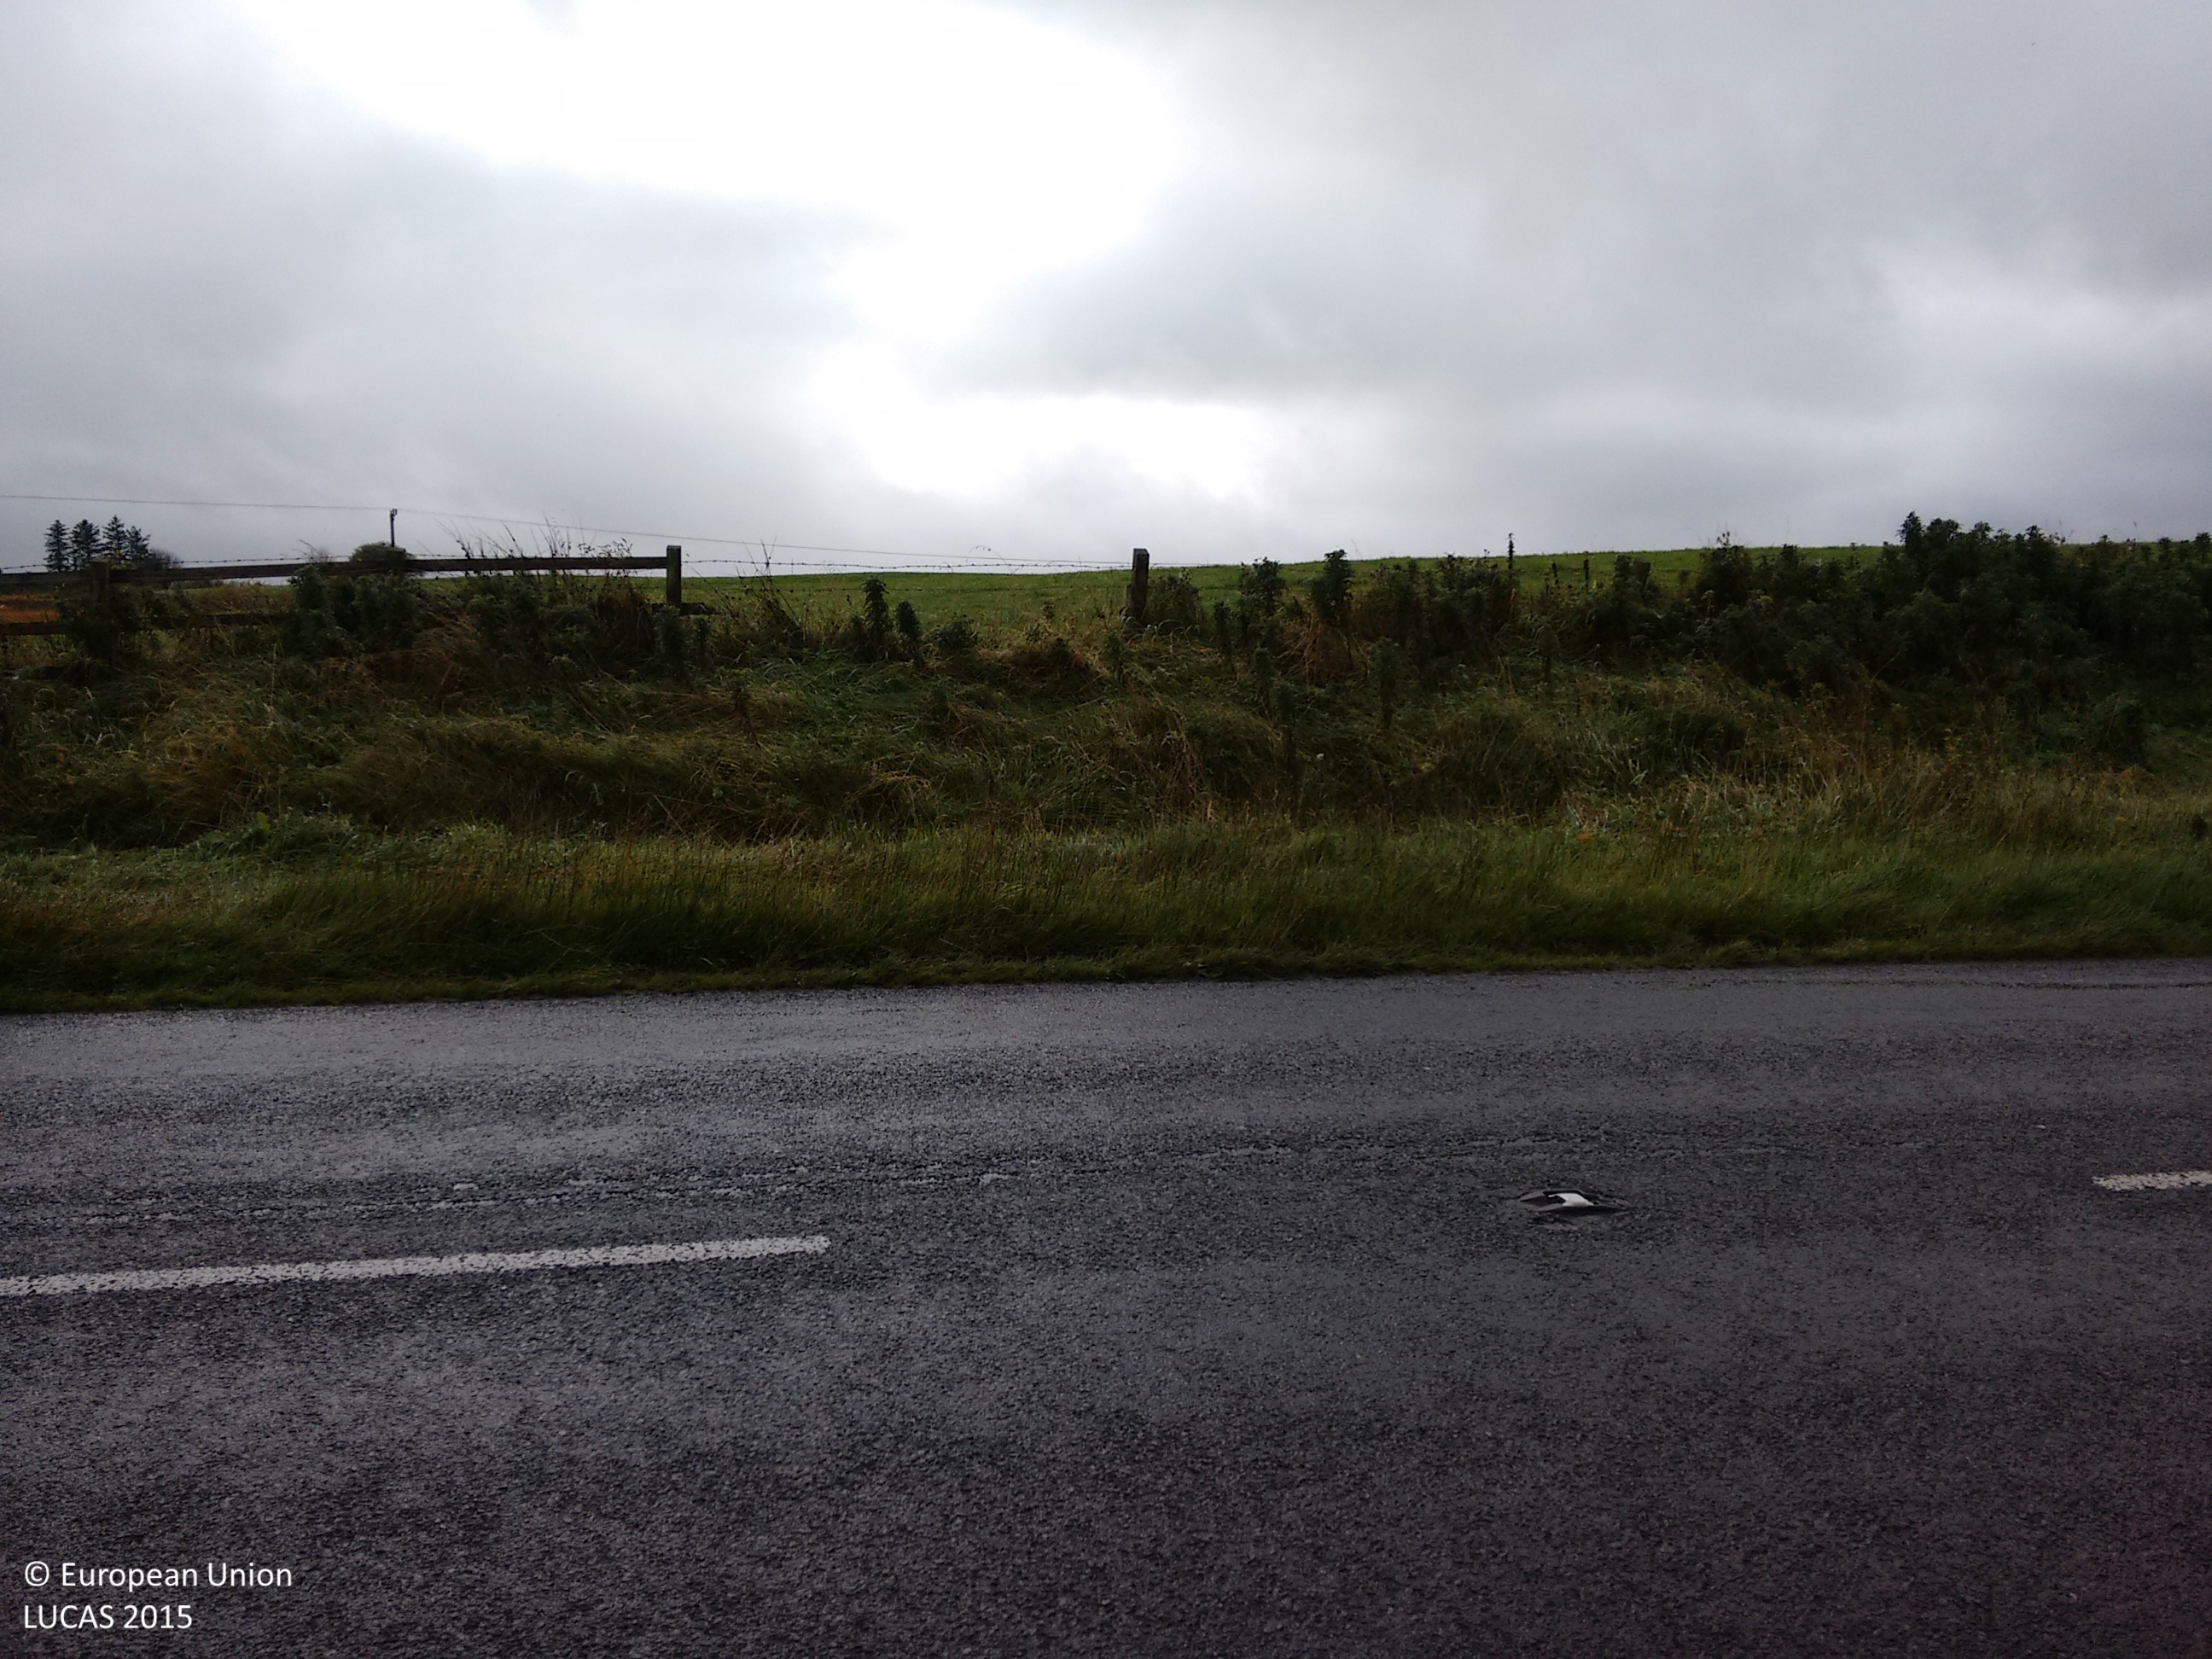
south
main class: Grassland
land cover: Grassland without tree/shrub cover
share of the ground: > 75 %
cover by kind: herbaceous plants 100 %
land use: Agriculture (excluding fallow land and kitchen gardens)
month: October
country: GB
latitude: 54.5481
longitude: -7.4853
